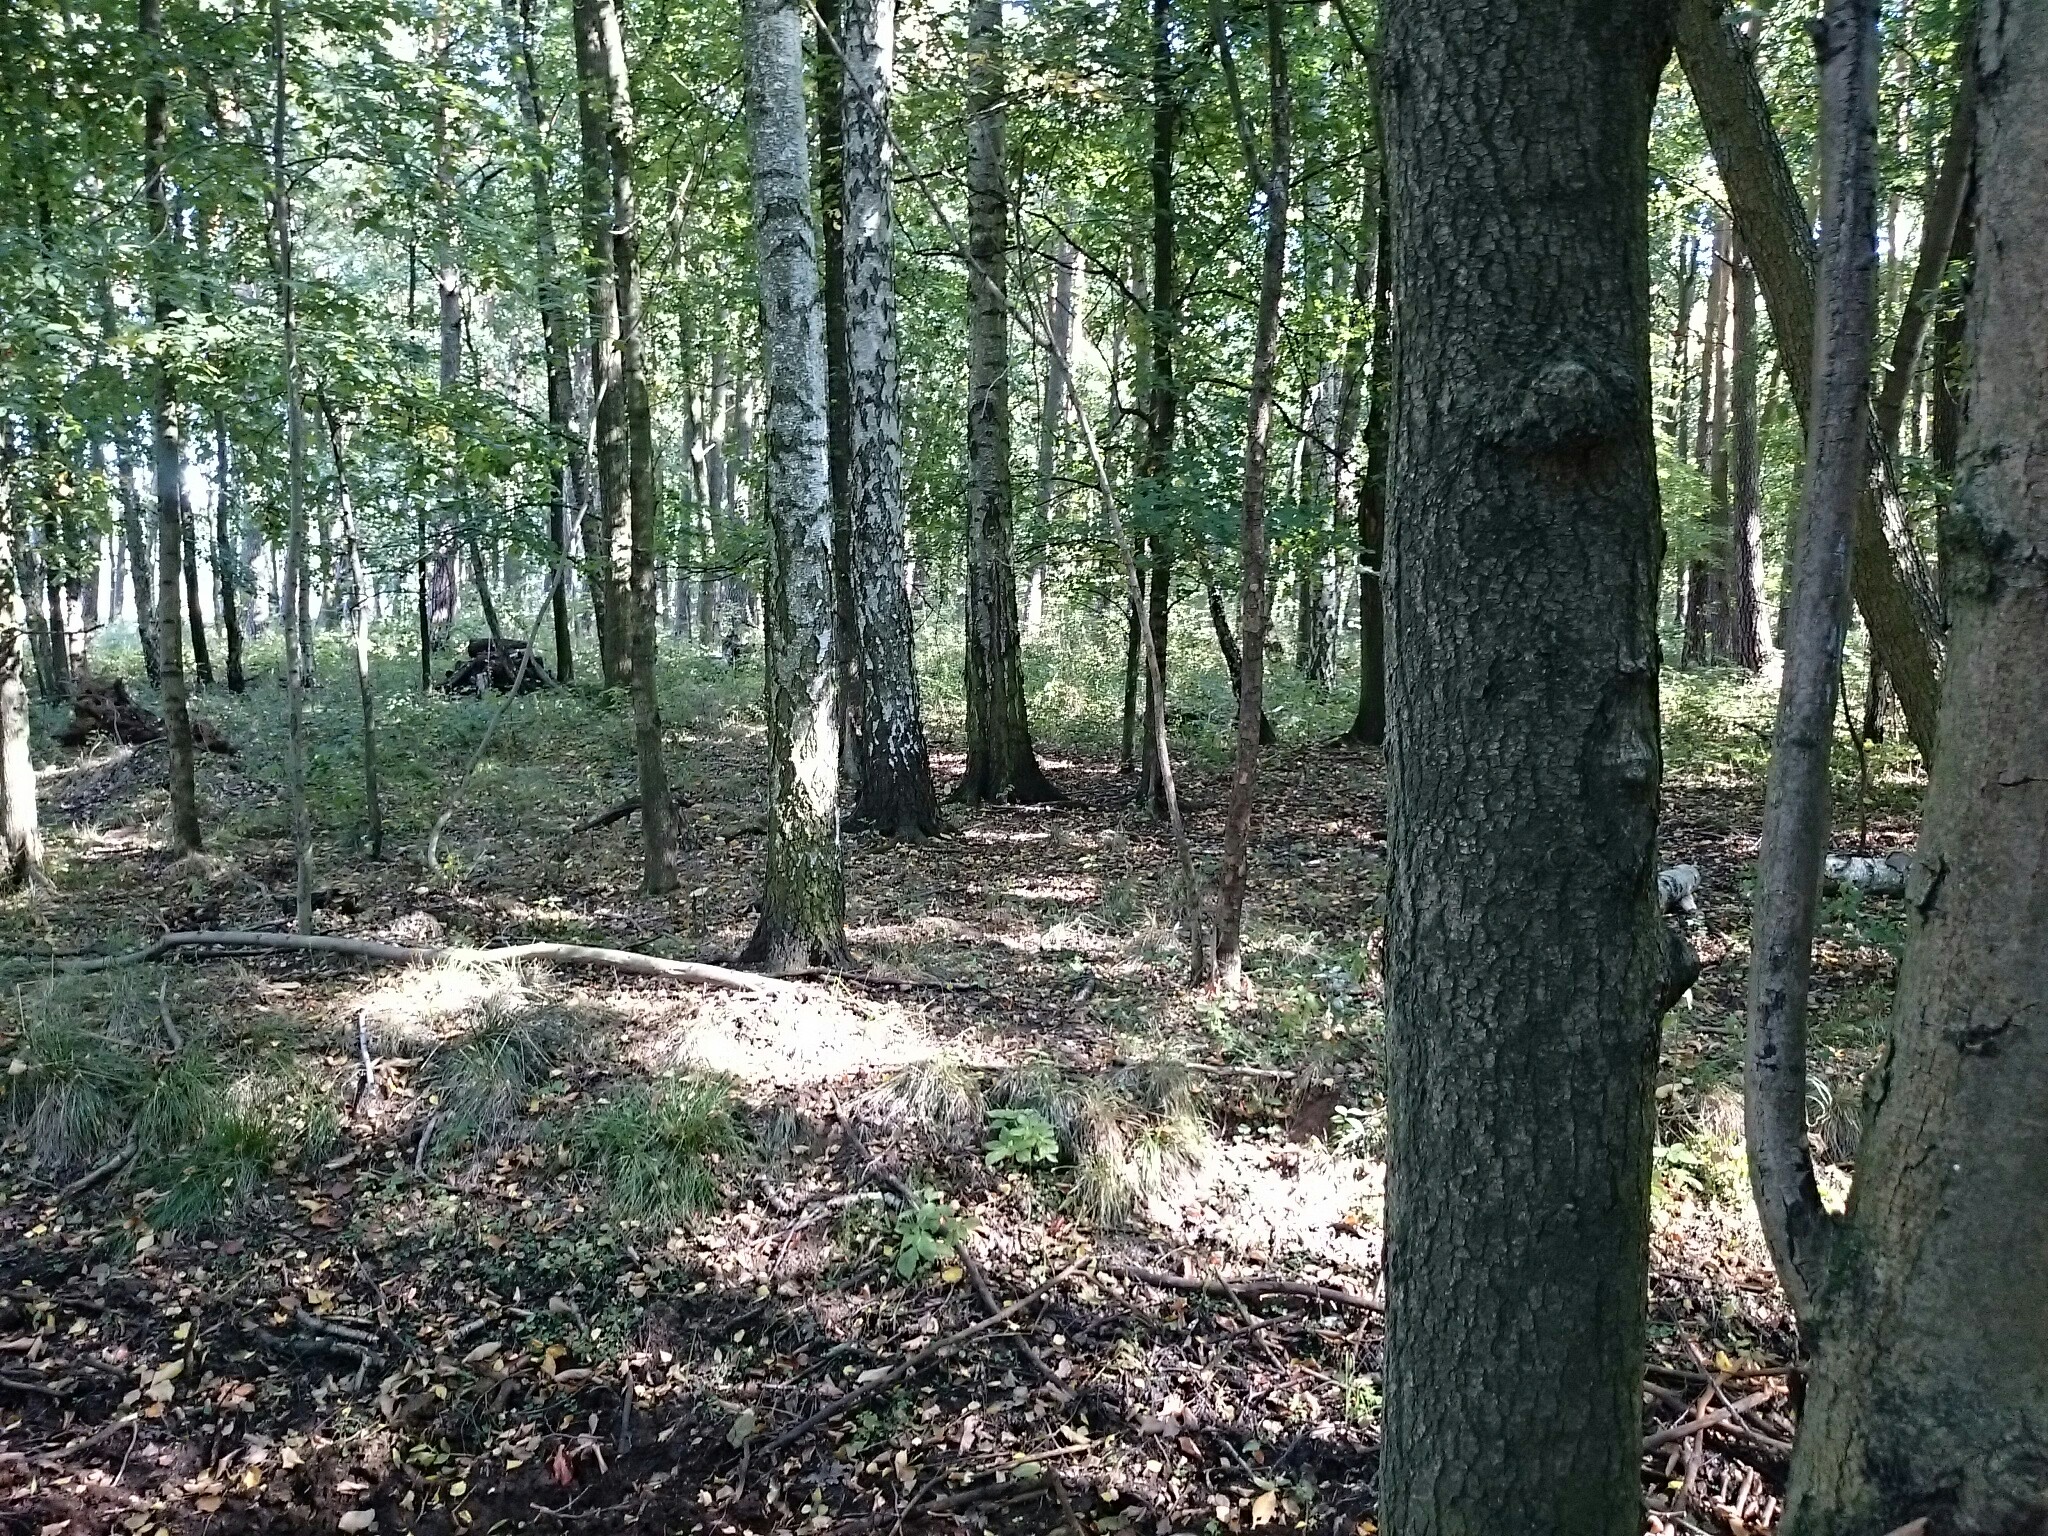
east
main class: Woodland
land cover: Broadleaved woodland
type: mesophytic deciduous forest
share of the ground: > 75 %
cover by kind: broadleaved forest trees 80 %, unconsolidated bare surface 15 %, herbaceous plants 5 %
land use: Forestry
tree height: > 5 m
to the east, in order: Broadleaved woodland; Ditches and canals; Broadleaved woodland; Pine dominated mixed woodland
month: September
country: PL
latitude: 51.5357
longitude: 17.3501
